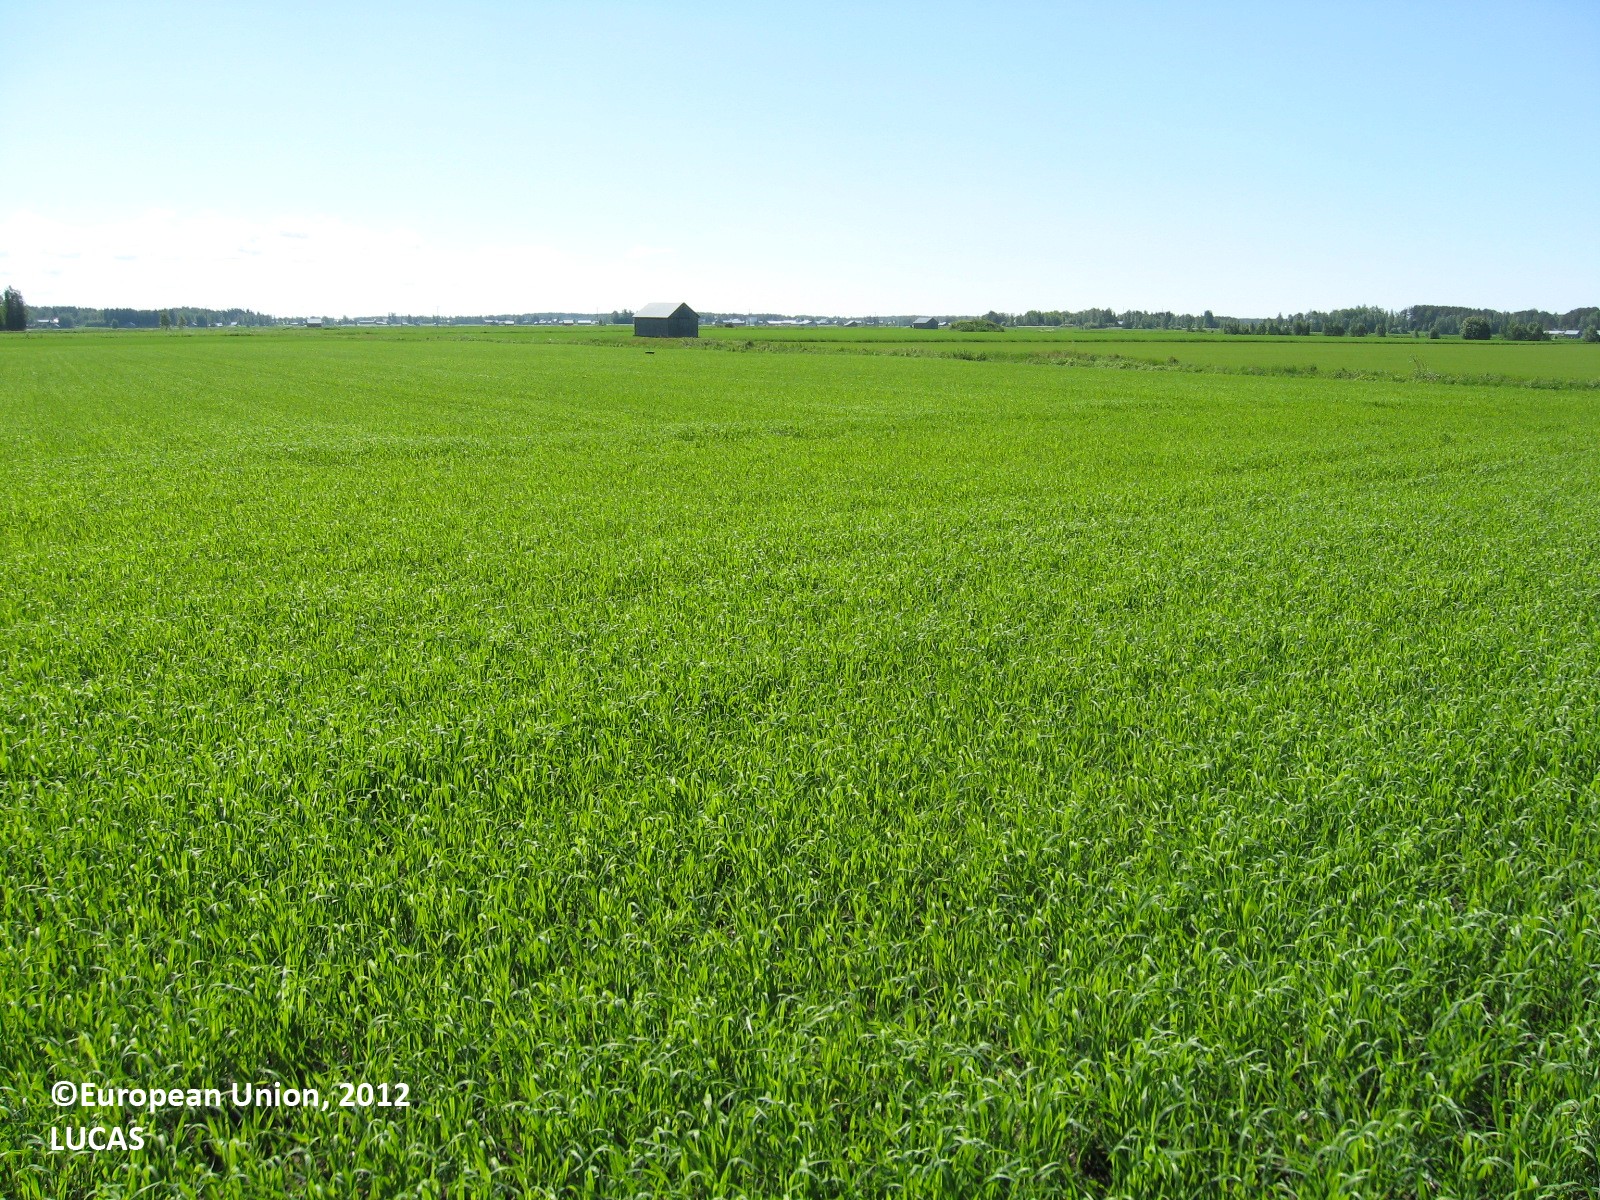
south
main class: Cropland
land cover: Oats
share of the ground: > 75 %
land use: Agriculture (excluding fallow land and kitchen gardens)
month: June
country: FI
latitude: 62.9441
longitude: 21.6484
